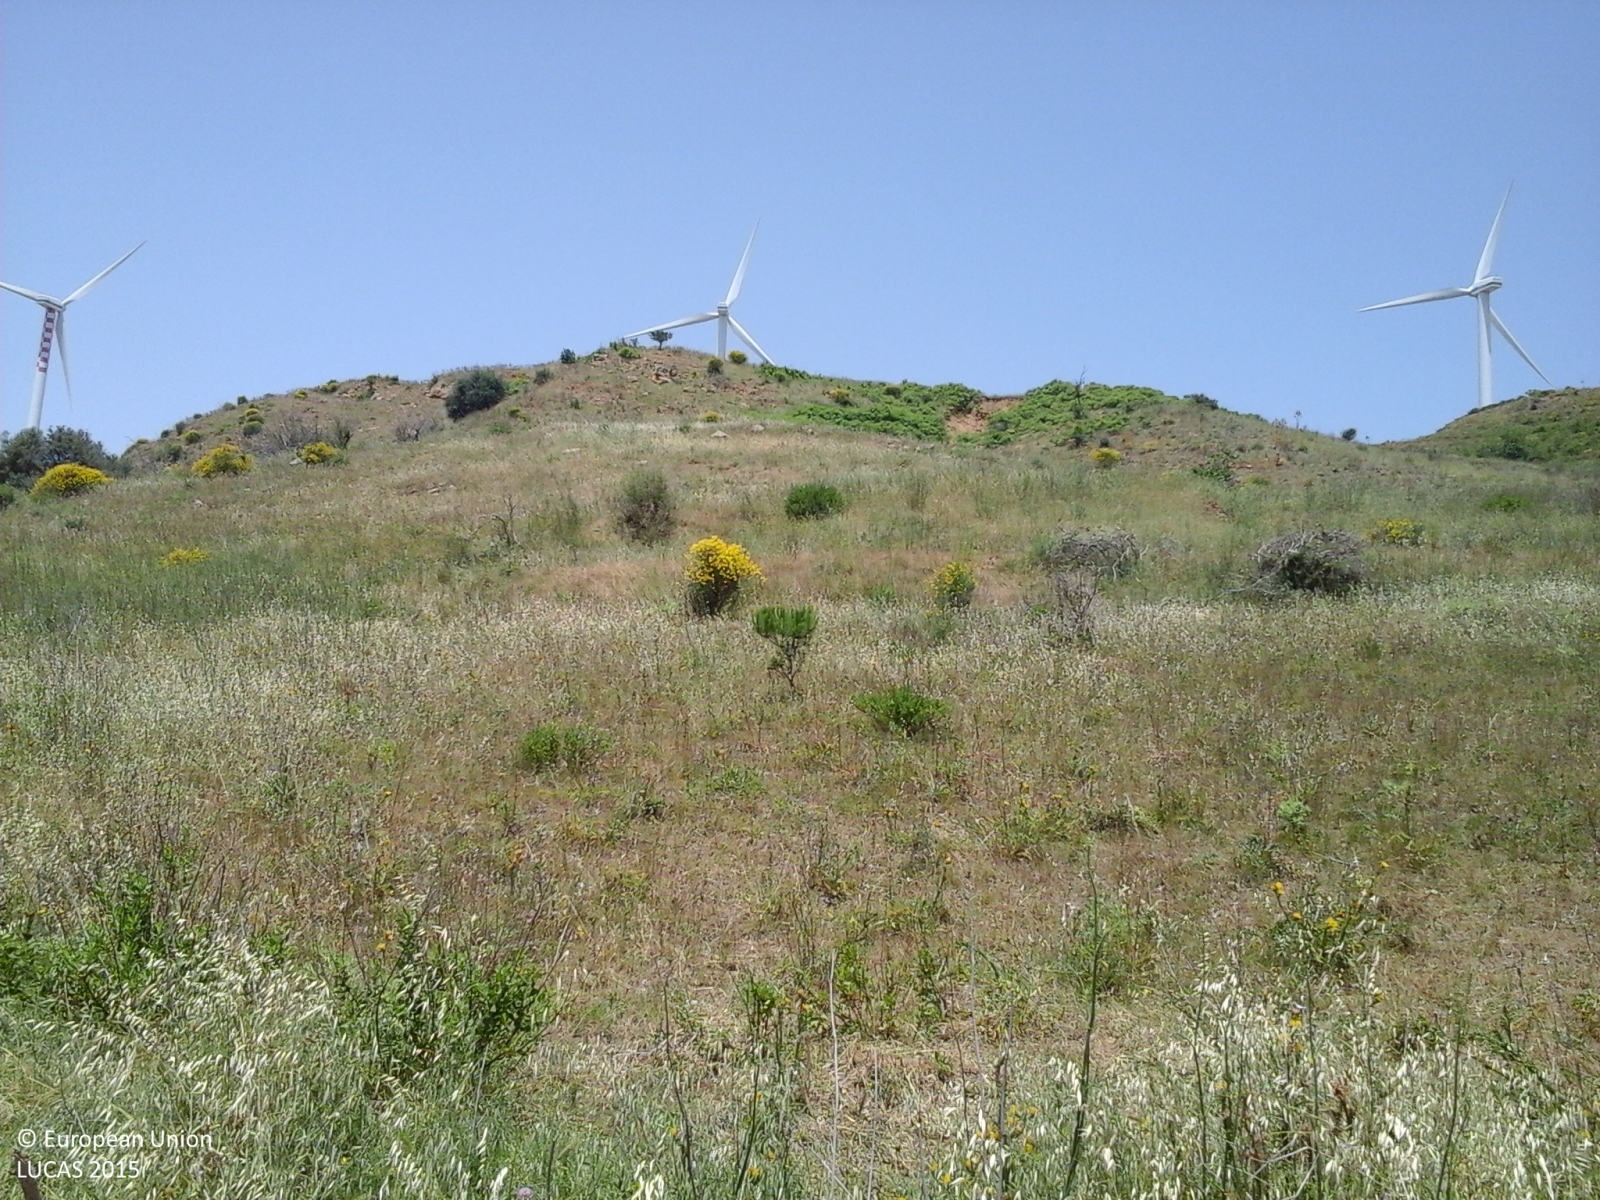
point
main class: Grassland
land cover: Grassland without tree/shrub cover
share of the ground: > 75 %
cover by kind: herbaceous plants 100 %
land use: Agriculture (excluding fallow land and kitchen gardens)
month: June
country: IT
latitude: 37.7643
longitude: 13.7528
